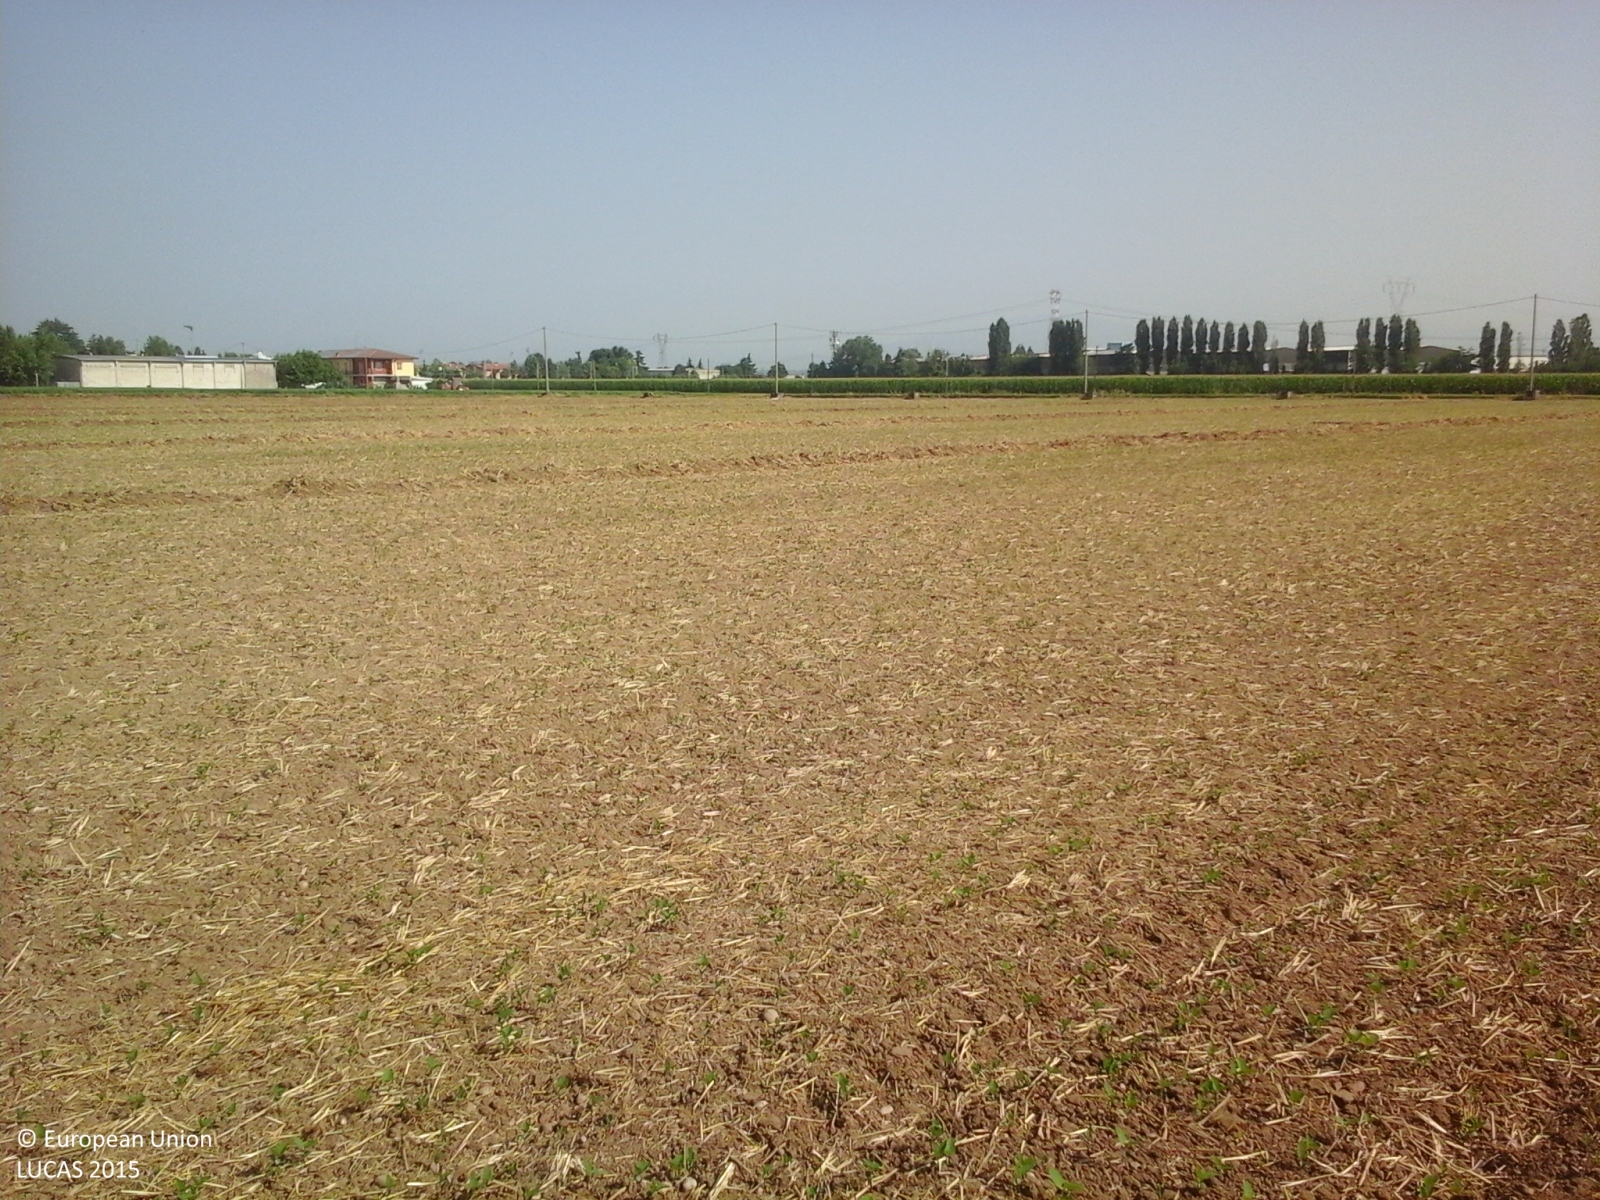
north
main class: Cropland
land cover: Maize
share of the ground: > 75 %
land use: Agriculture (excluding fallow land and kitchen gardens)
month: July
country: IT
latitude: 45.3029
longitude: 10.8275
